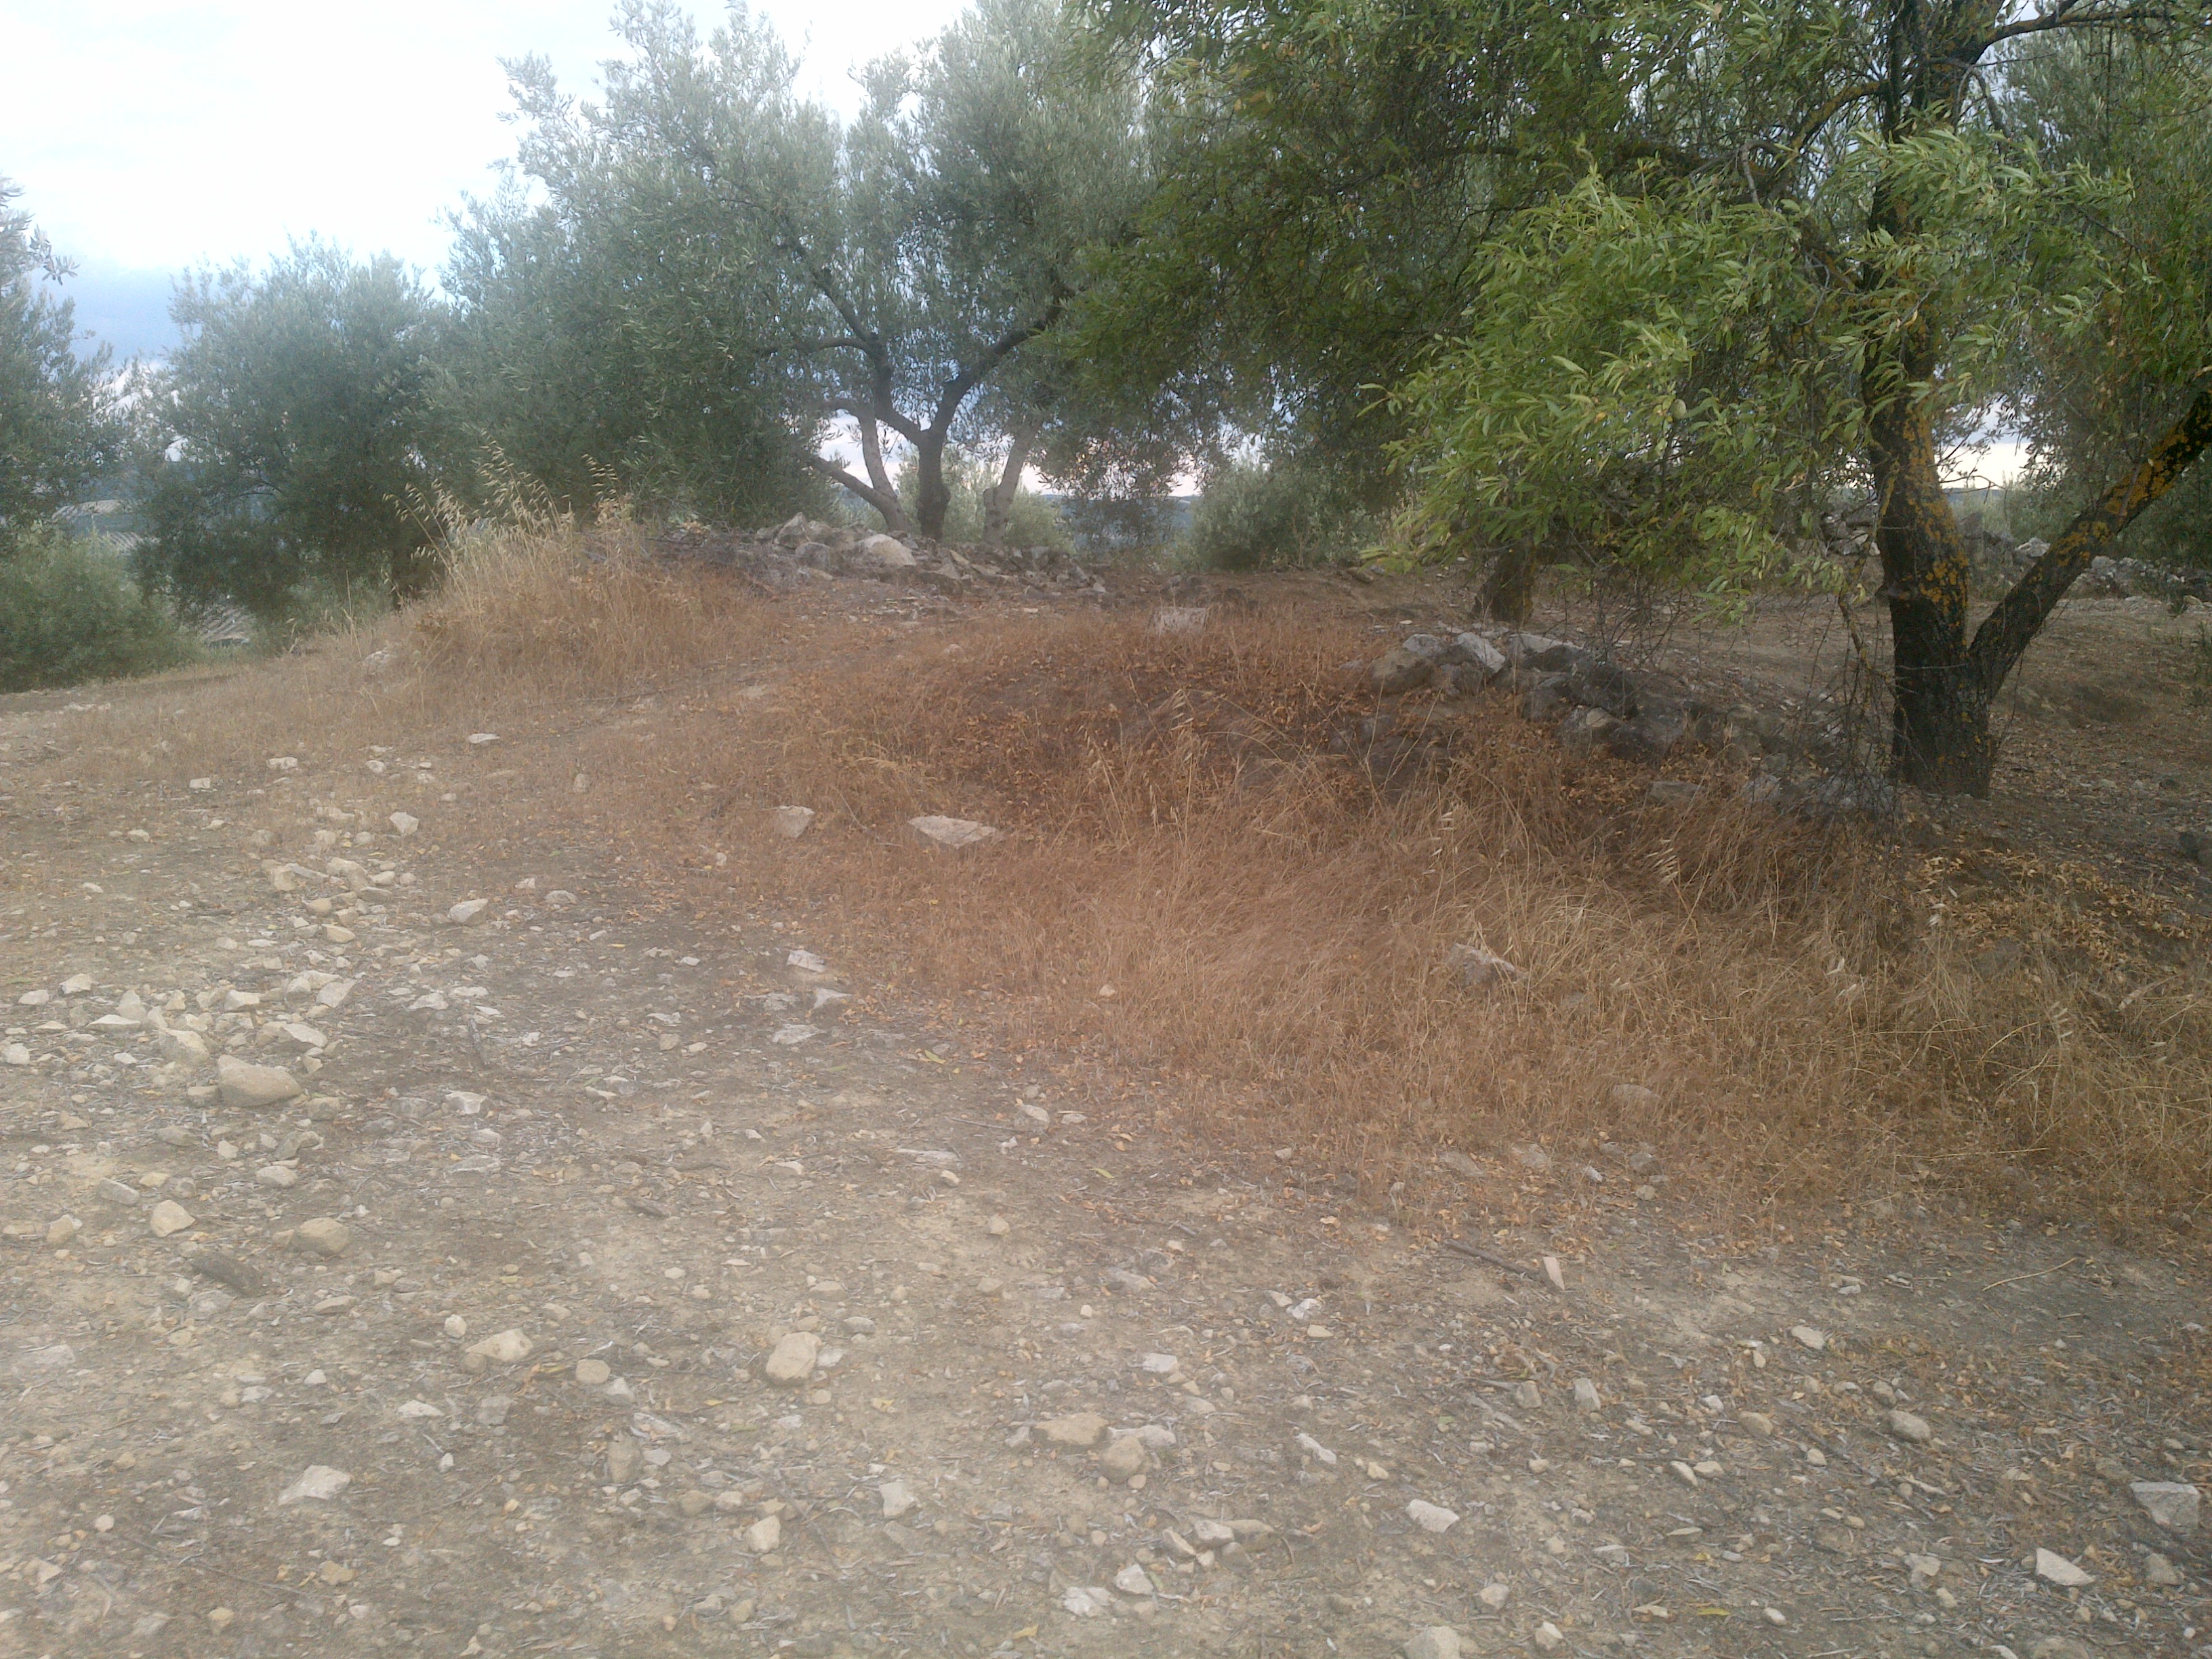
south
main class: Cropland
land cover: Olive groves
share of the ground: 25 - 50 %
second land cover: Other bare soil
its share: > 75 %
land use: Agriculture (excluding fallow land and kitchen gardens)
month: June
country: ES
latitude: 37.7011
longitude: -4.4684
